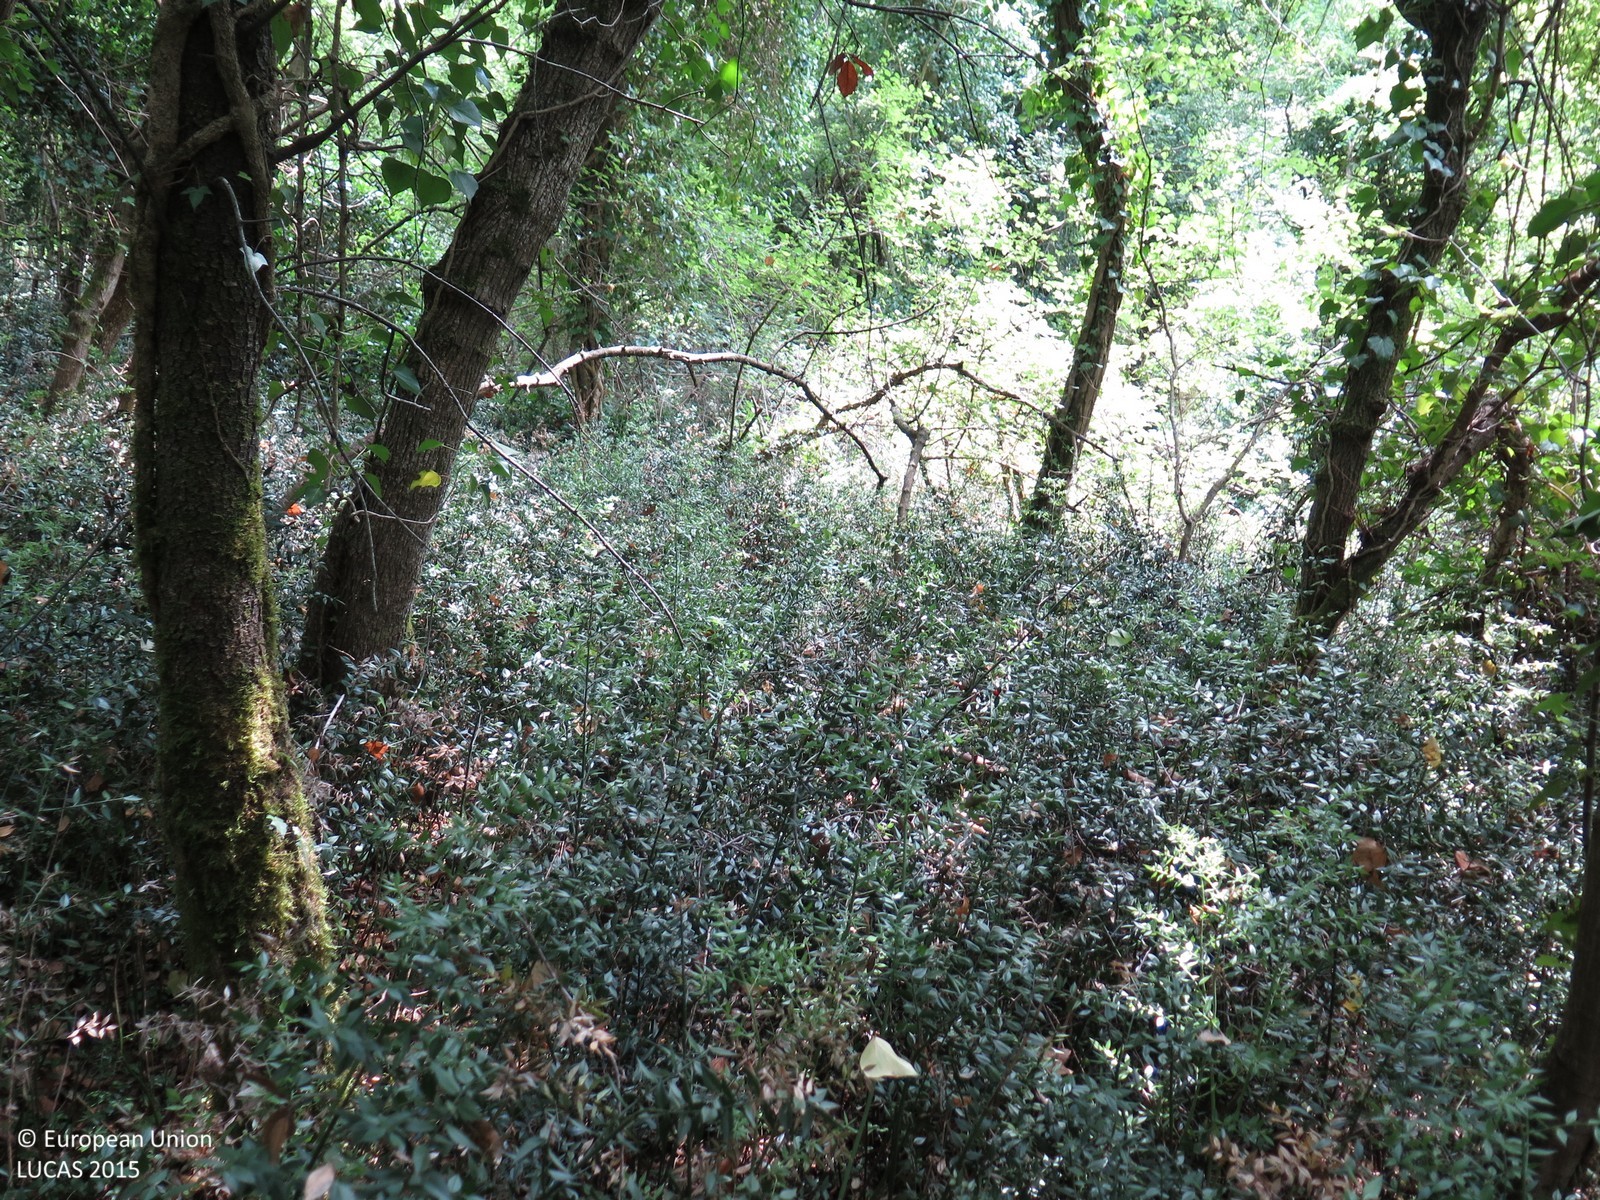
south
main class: Woodland
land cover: Broadleaved woodland
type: mesophytic deciduous forest
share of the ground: > 75 %
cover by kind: broadleaved forest trees 95 %, shrubs 5 %
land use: Semi-natural and natural areas not in use
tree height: > 5 m
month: June
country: HR
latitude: 45.1537
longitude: 13.6199
